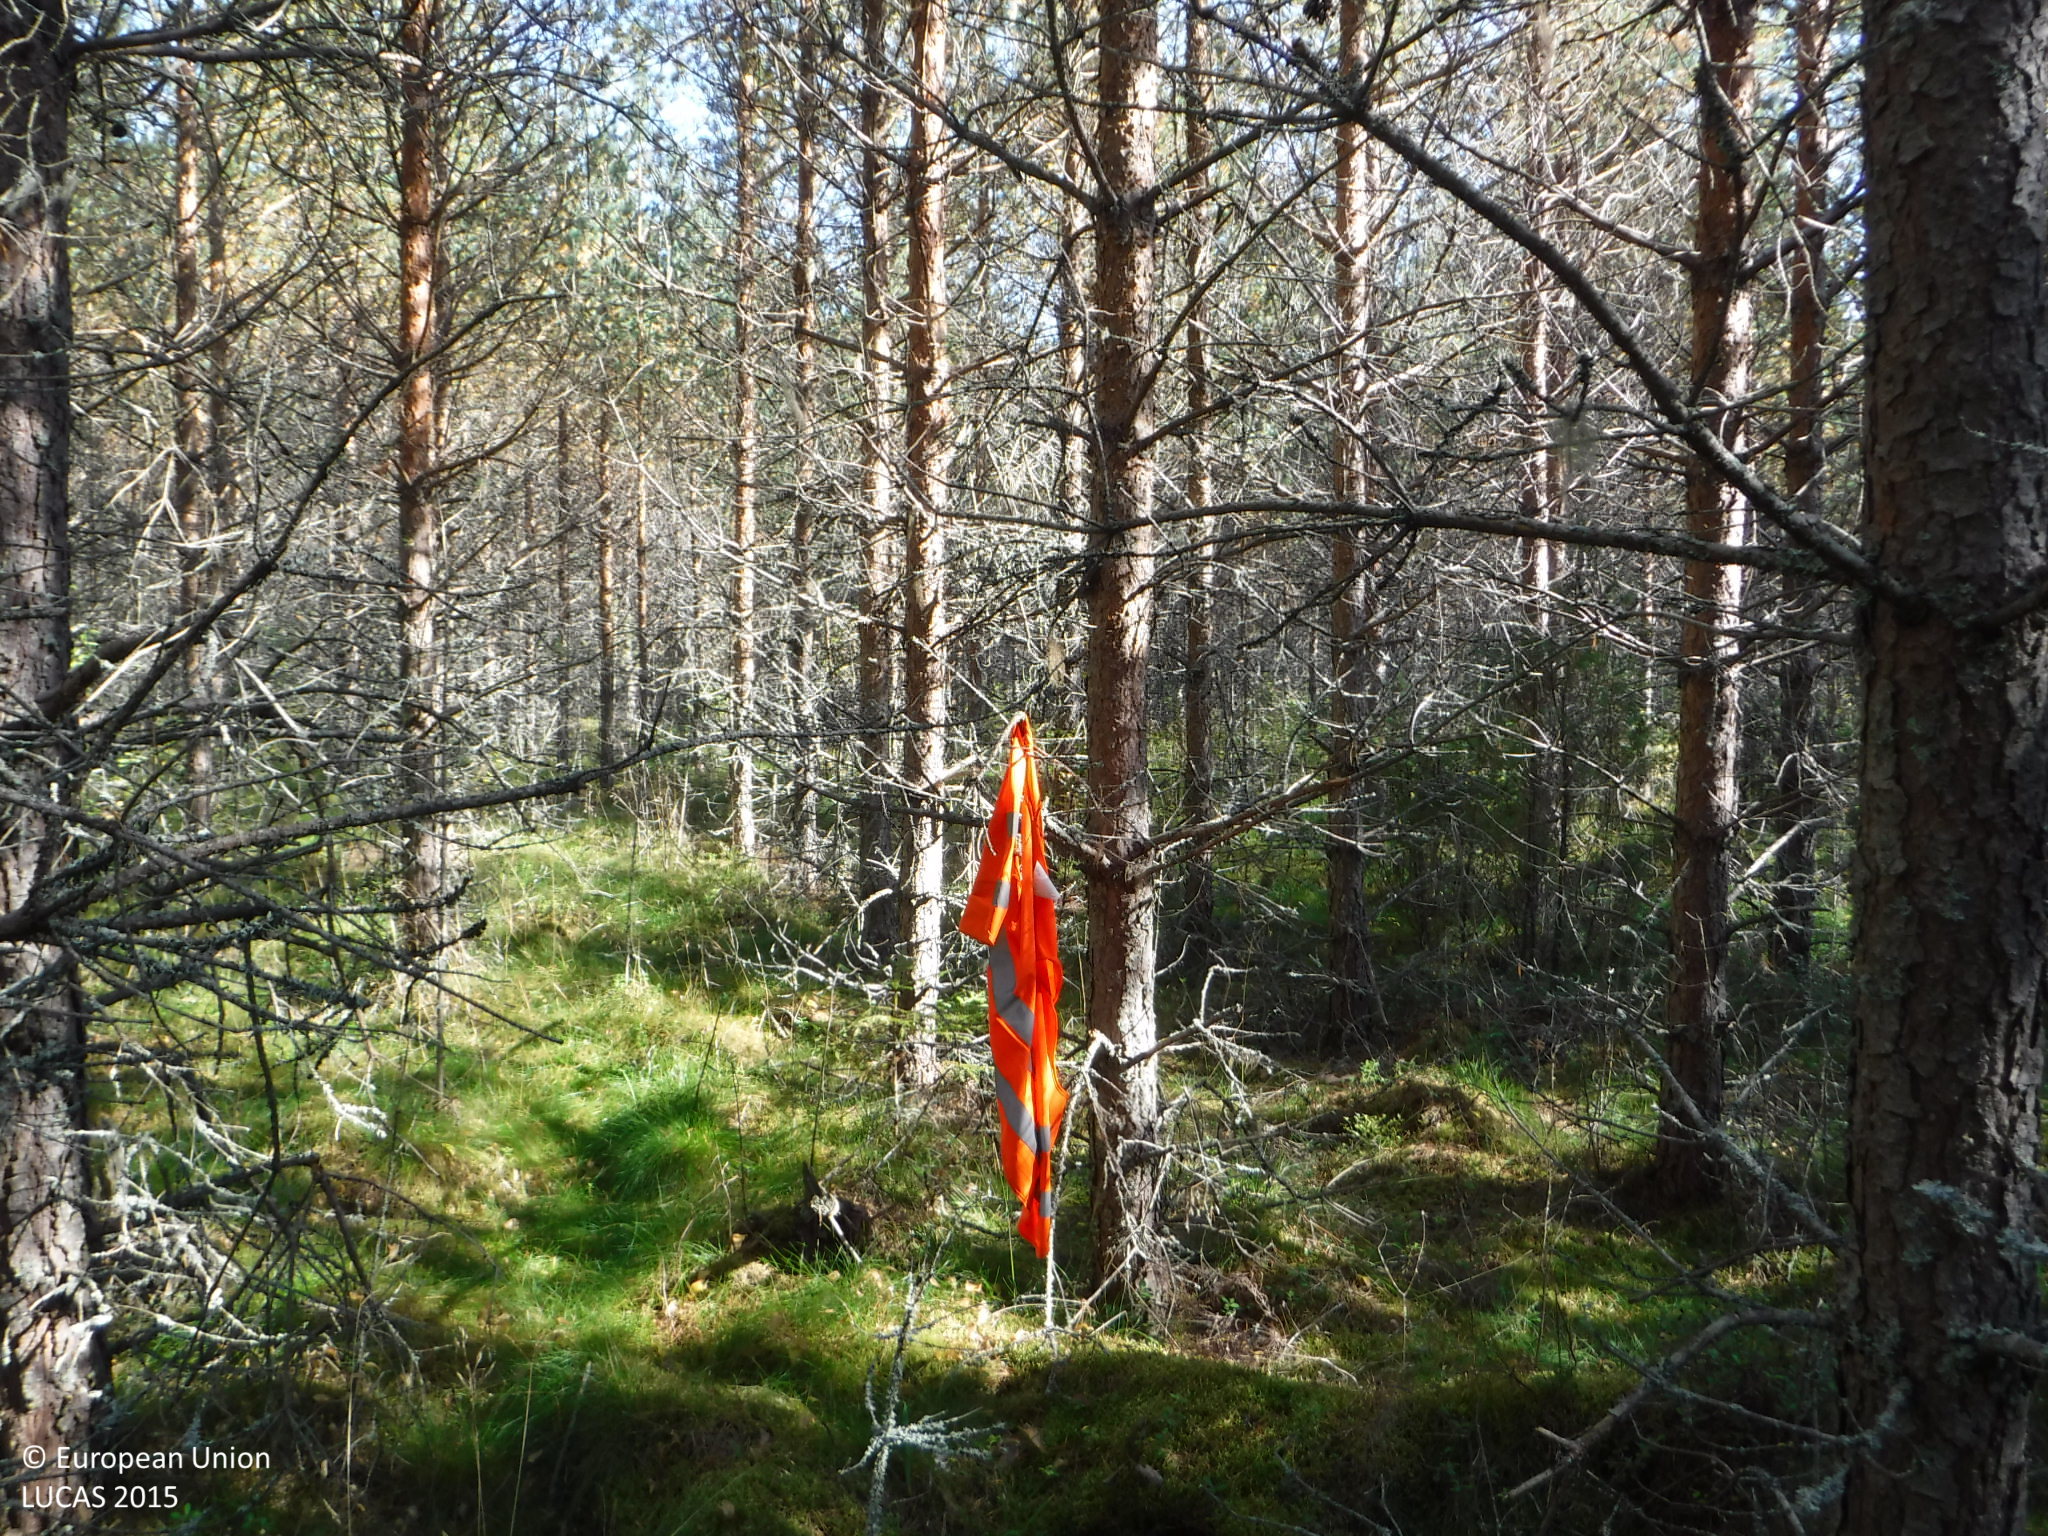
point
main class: Woodland
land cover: Pine dominated coniferous woodland
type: boreal forest
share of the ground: > 75 %
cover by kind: coniferous forest trees 75 %, herbaceous plants 25 %
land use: Forestry
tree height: > 5 m
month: September
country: FI
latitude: 61.7687
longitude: 22.8197
